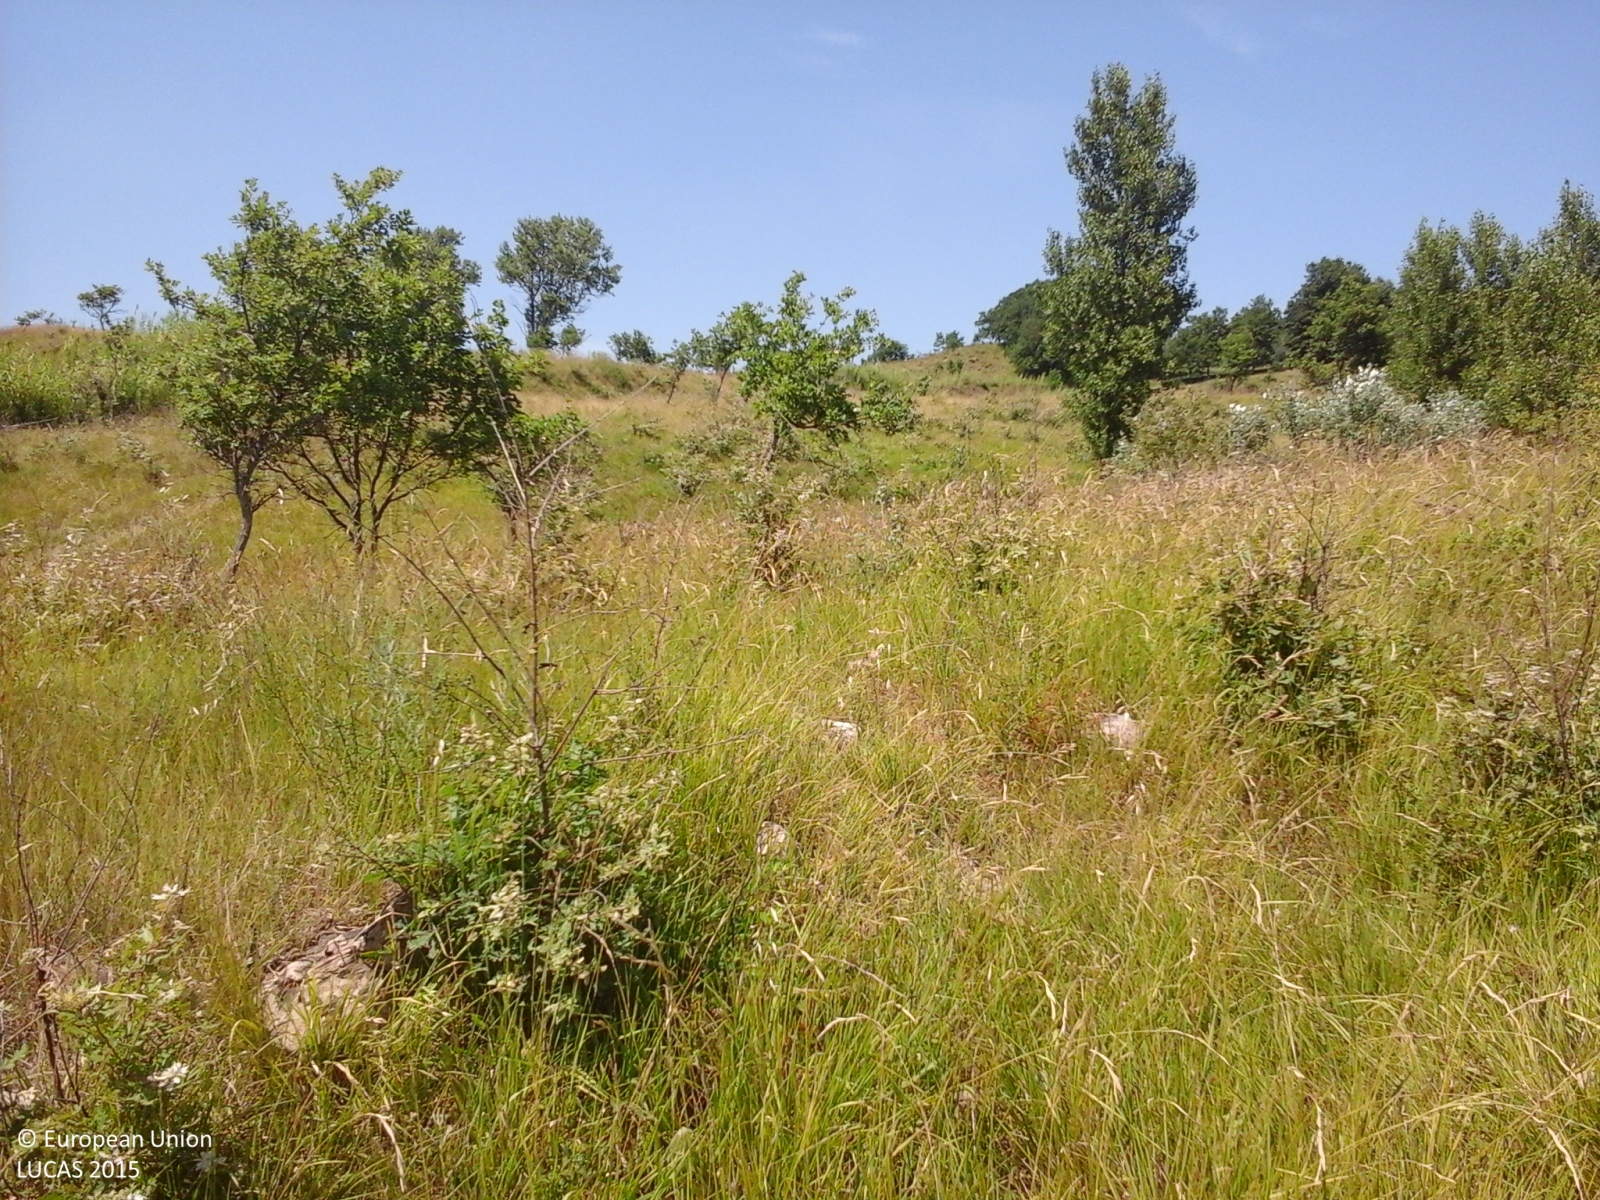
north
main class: Shrubland
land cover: Shrubland with sparse tree cover
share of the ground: > 75 %
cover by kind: herbaceous plants 60 %, shrubs 35 %, broadleaved forest trees 5 %
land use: Abandoned areas
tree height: > 5 m
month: July
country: IT
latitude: 41.0616
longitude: 14.6822
